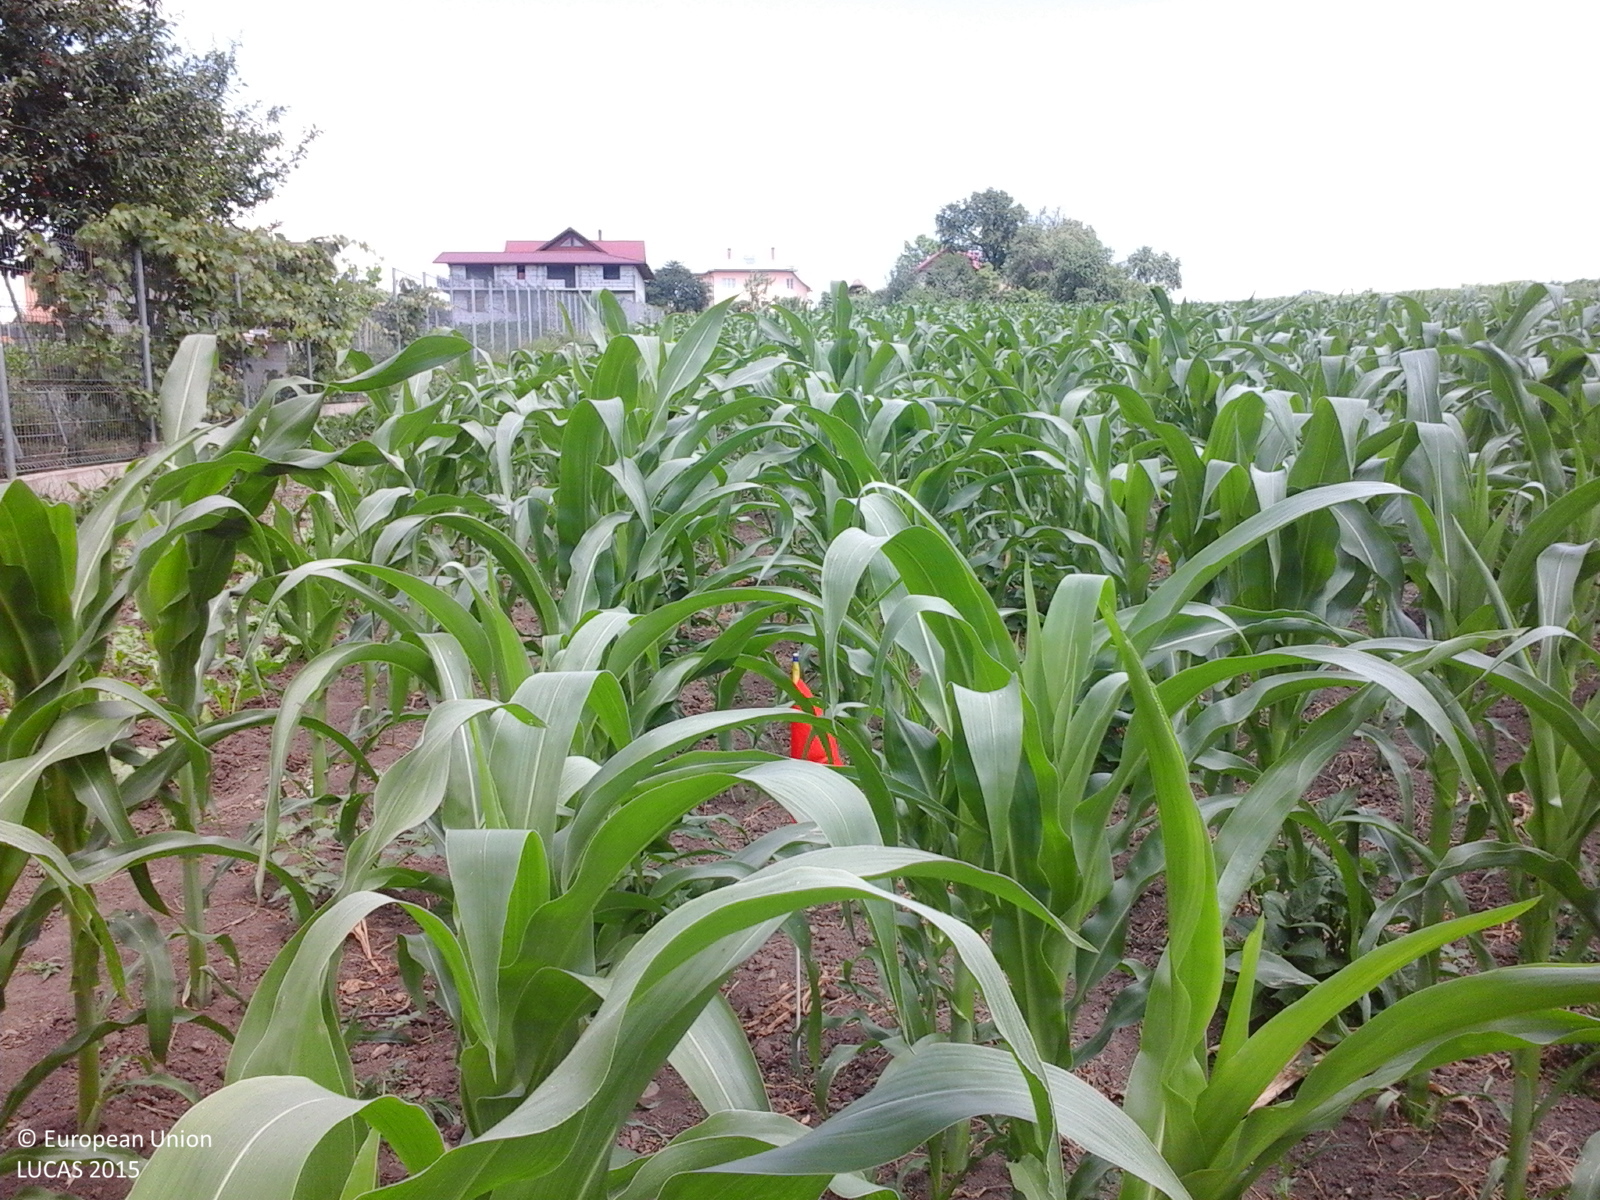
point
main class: Cropland
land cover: Maize
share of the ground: 50 - 75 %
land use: Agriculture (excluding fallow land and kitchen gardens)
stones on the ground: < 10 %
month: June
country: RO
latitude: 47.6539
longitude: 26.3420
